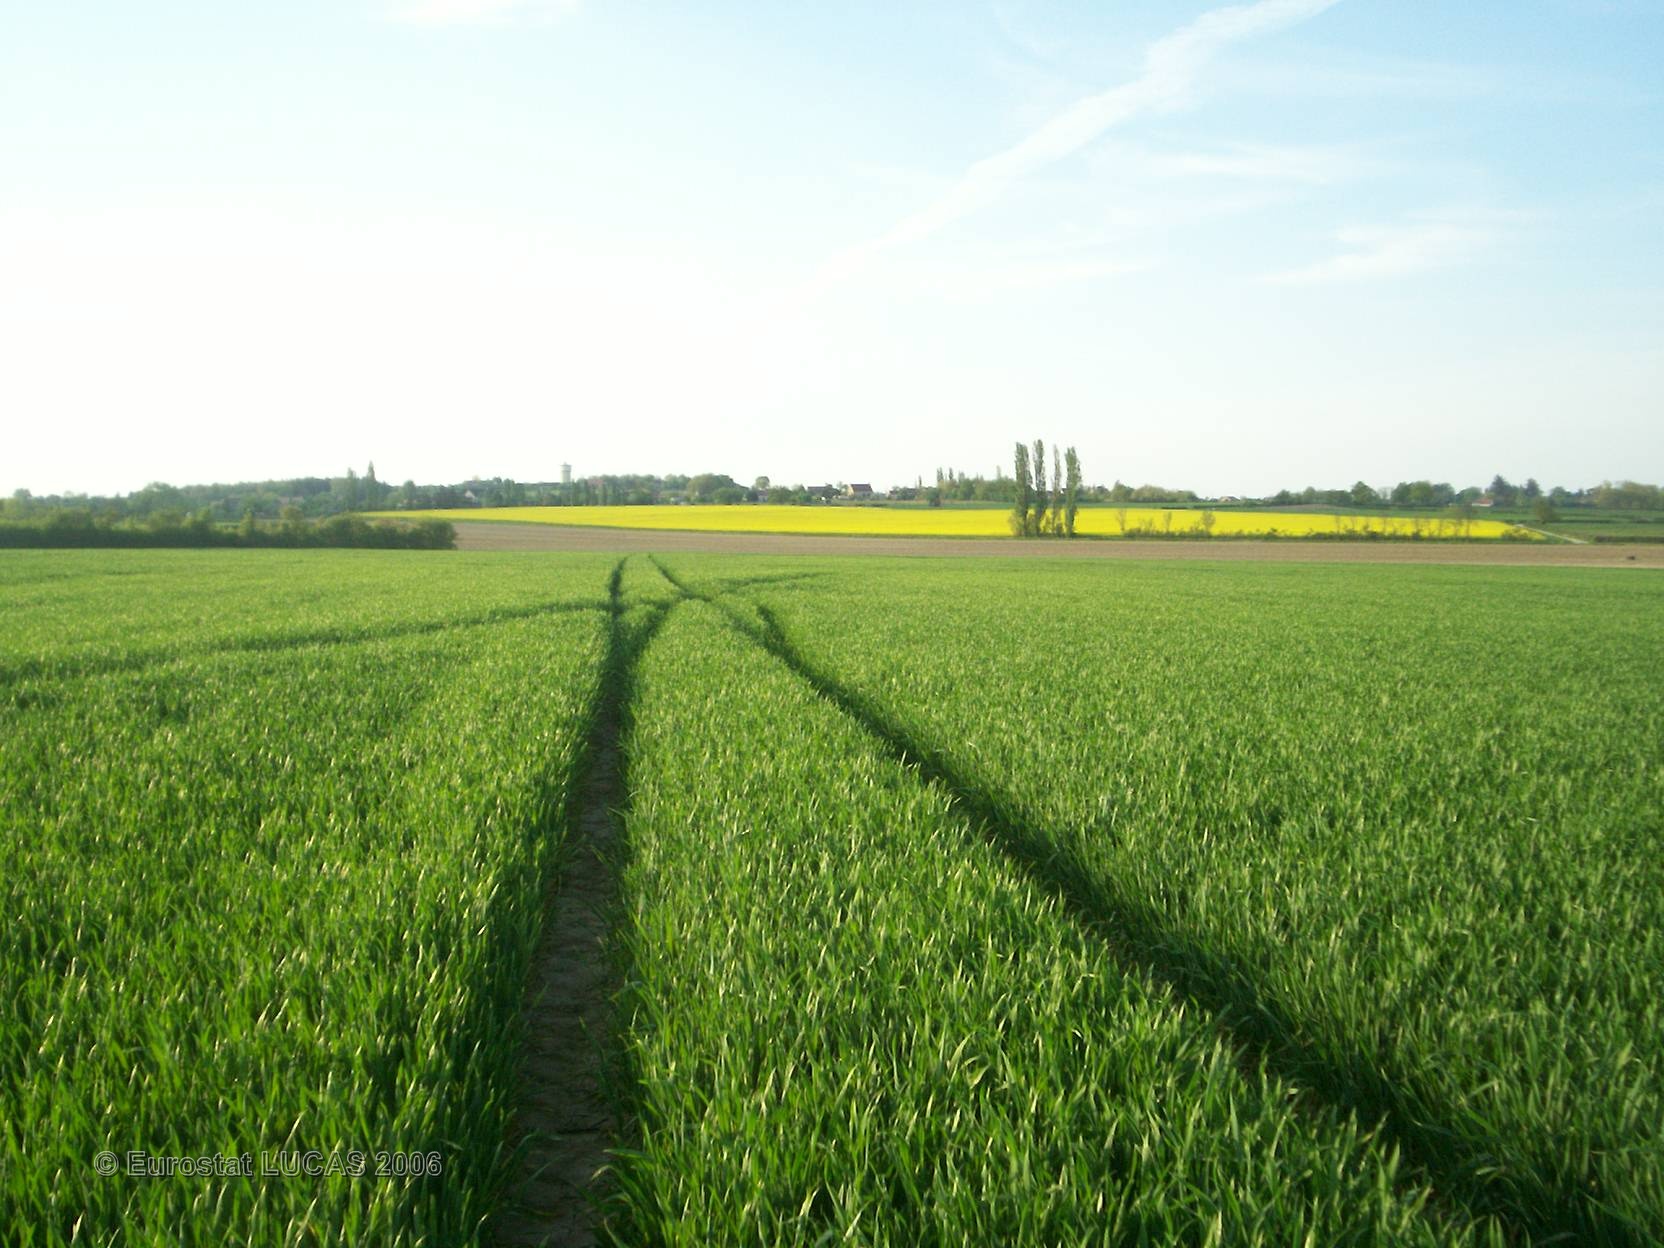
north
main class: Cropland
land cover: Barley
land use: Agriculture (excluding fallow land and kitchen gardens)
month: May
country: FR
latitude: 46.2213
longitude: 3.1404
